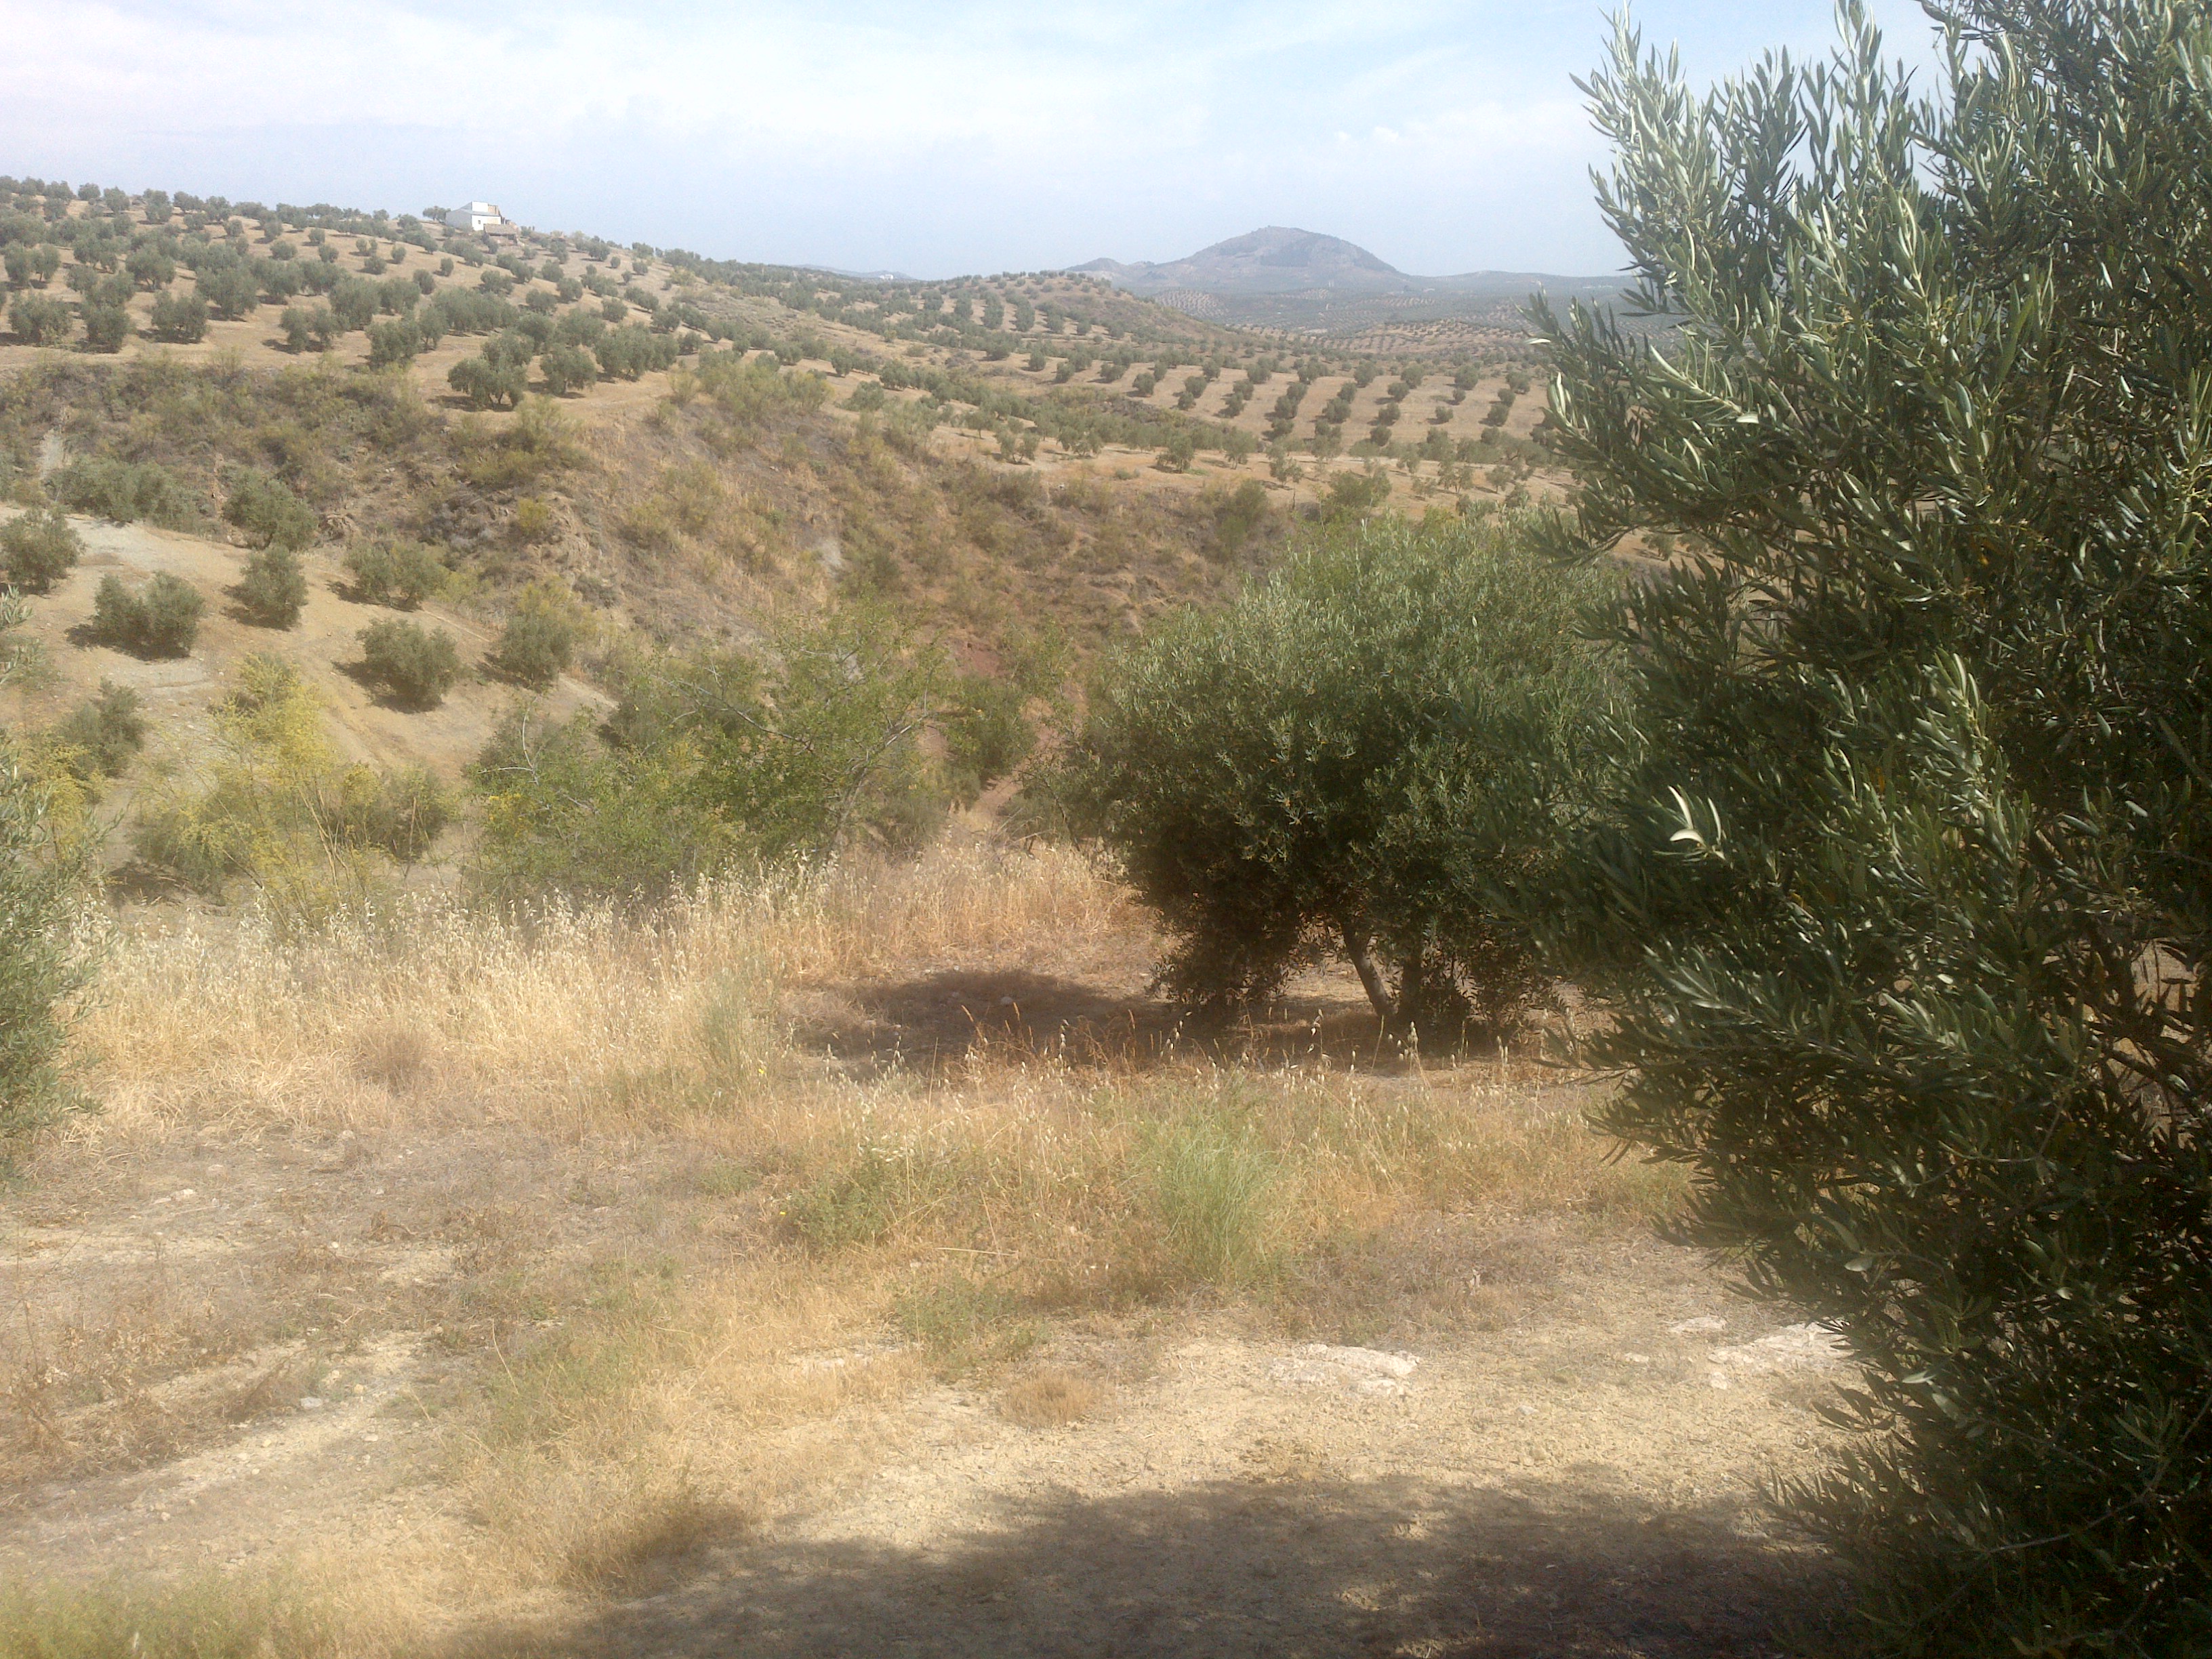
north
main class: Cropland
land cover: Olive groves
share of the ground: 10 - 25 %
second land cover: Spontaneously vegetated surfaces
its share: 50 - 75 %
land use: Agriculture (excluding fallow land and kitchen gardens)
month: May
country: ES
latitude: 37.5168
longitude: -4.1087
